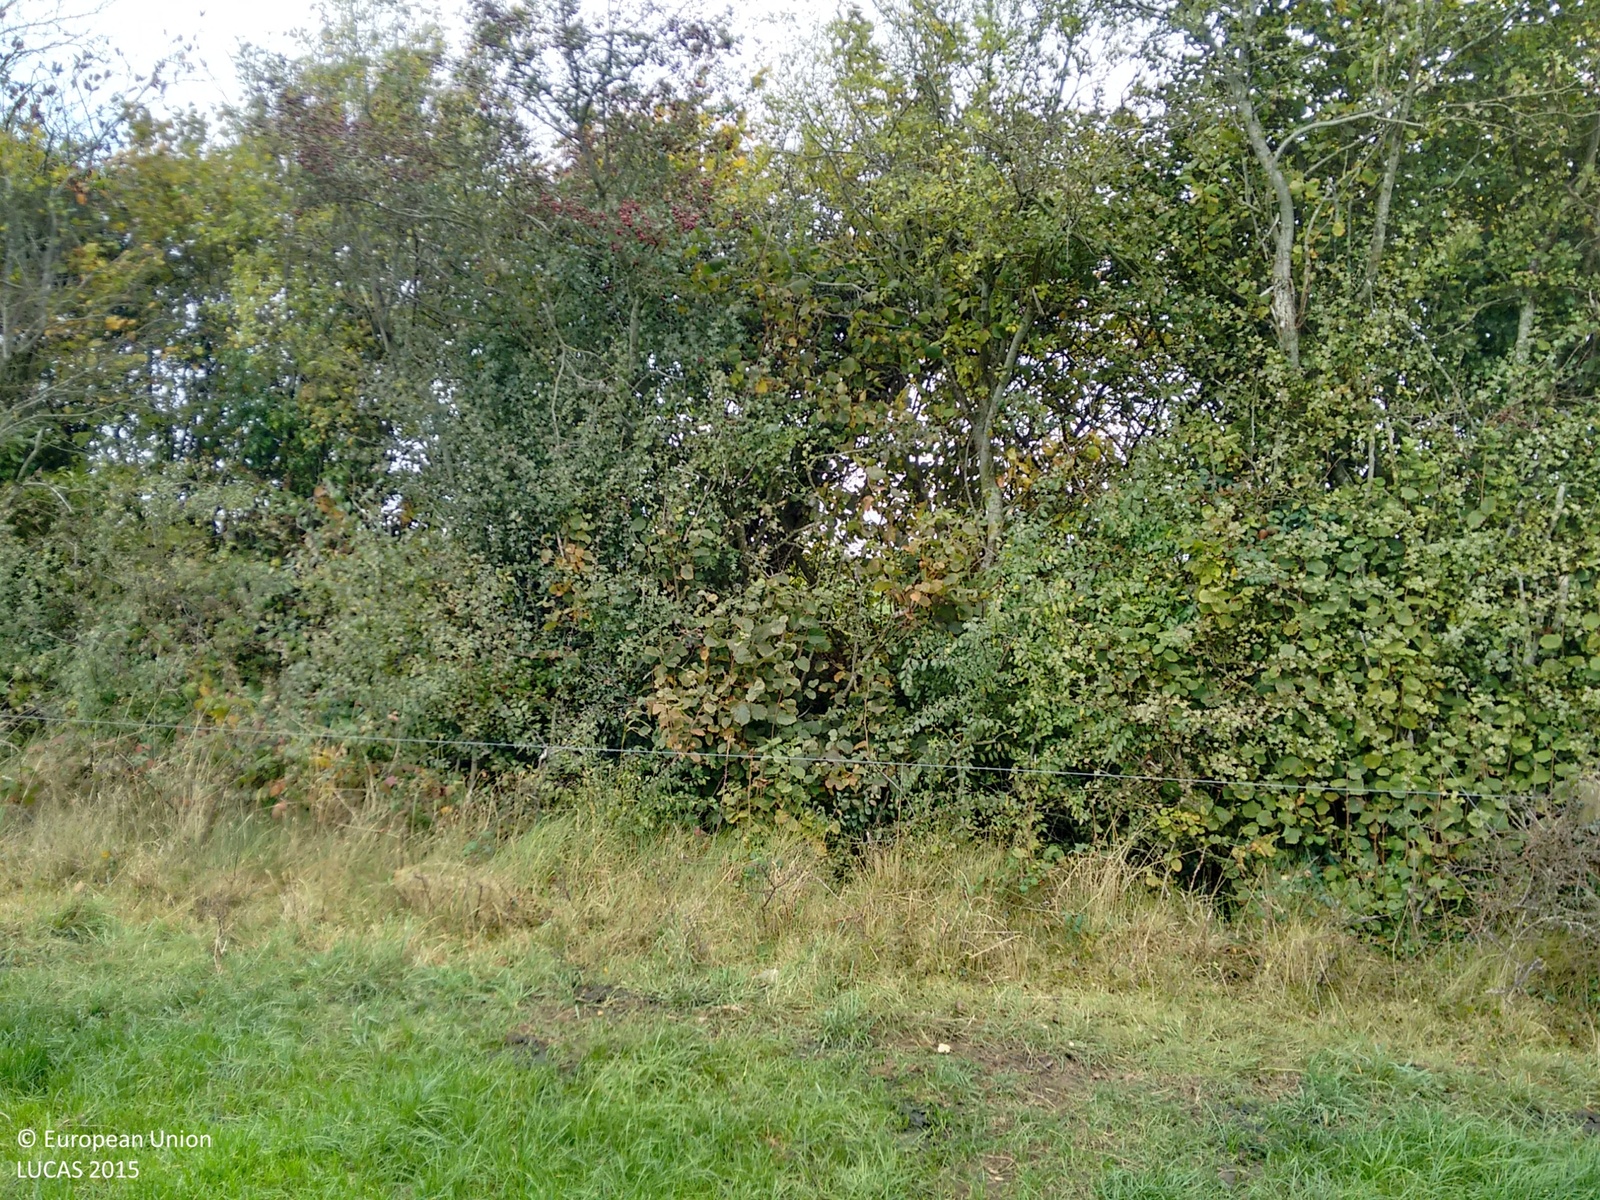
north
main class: Grassland
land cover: Grassland without tree/shrub cover
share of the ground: > 75 %
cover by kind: herbaceous plants 95 %, unconsolidated bare surface 5 %
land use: Agriculture (excluding fallow land and kitchen gardens)
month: October
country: IE
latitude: 52.7344
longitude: -7.7770
